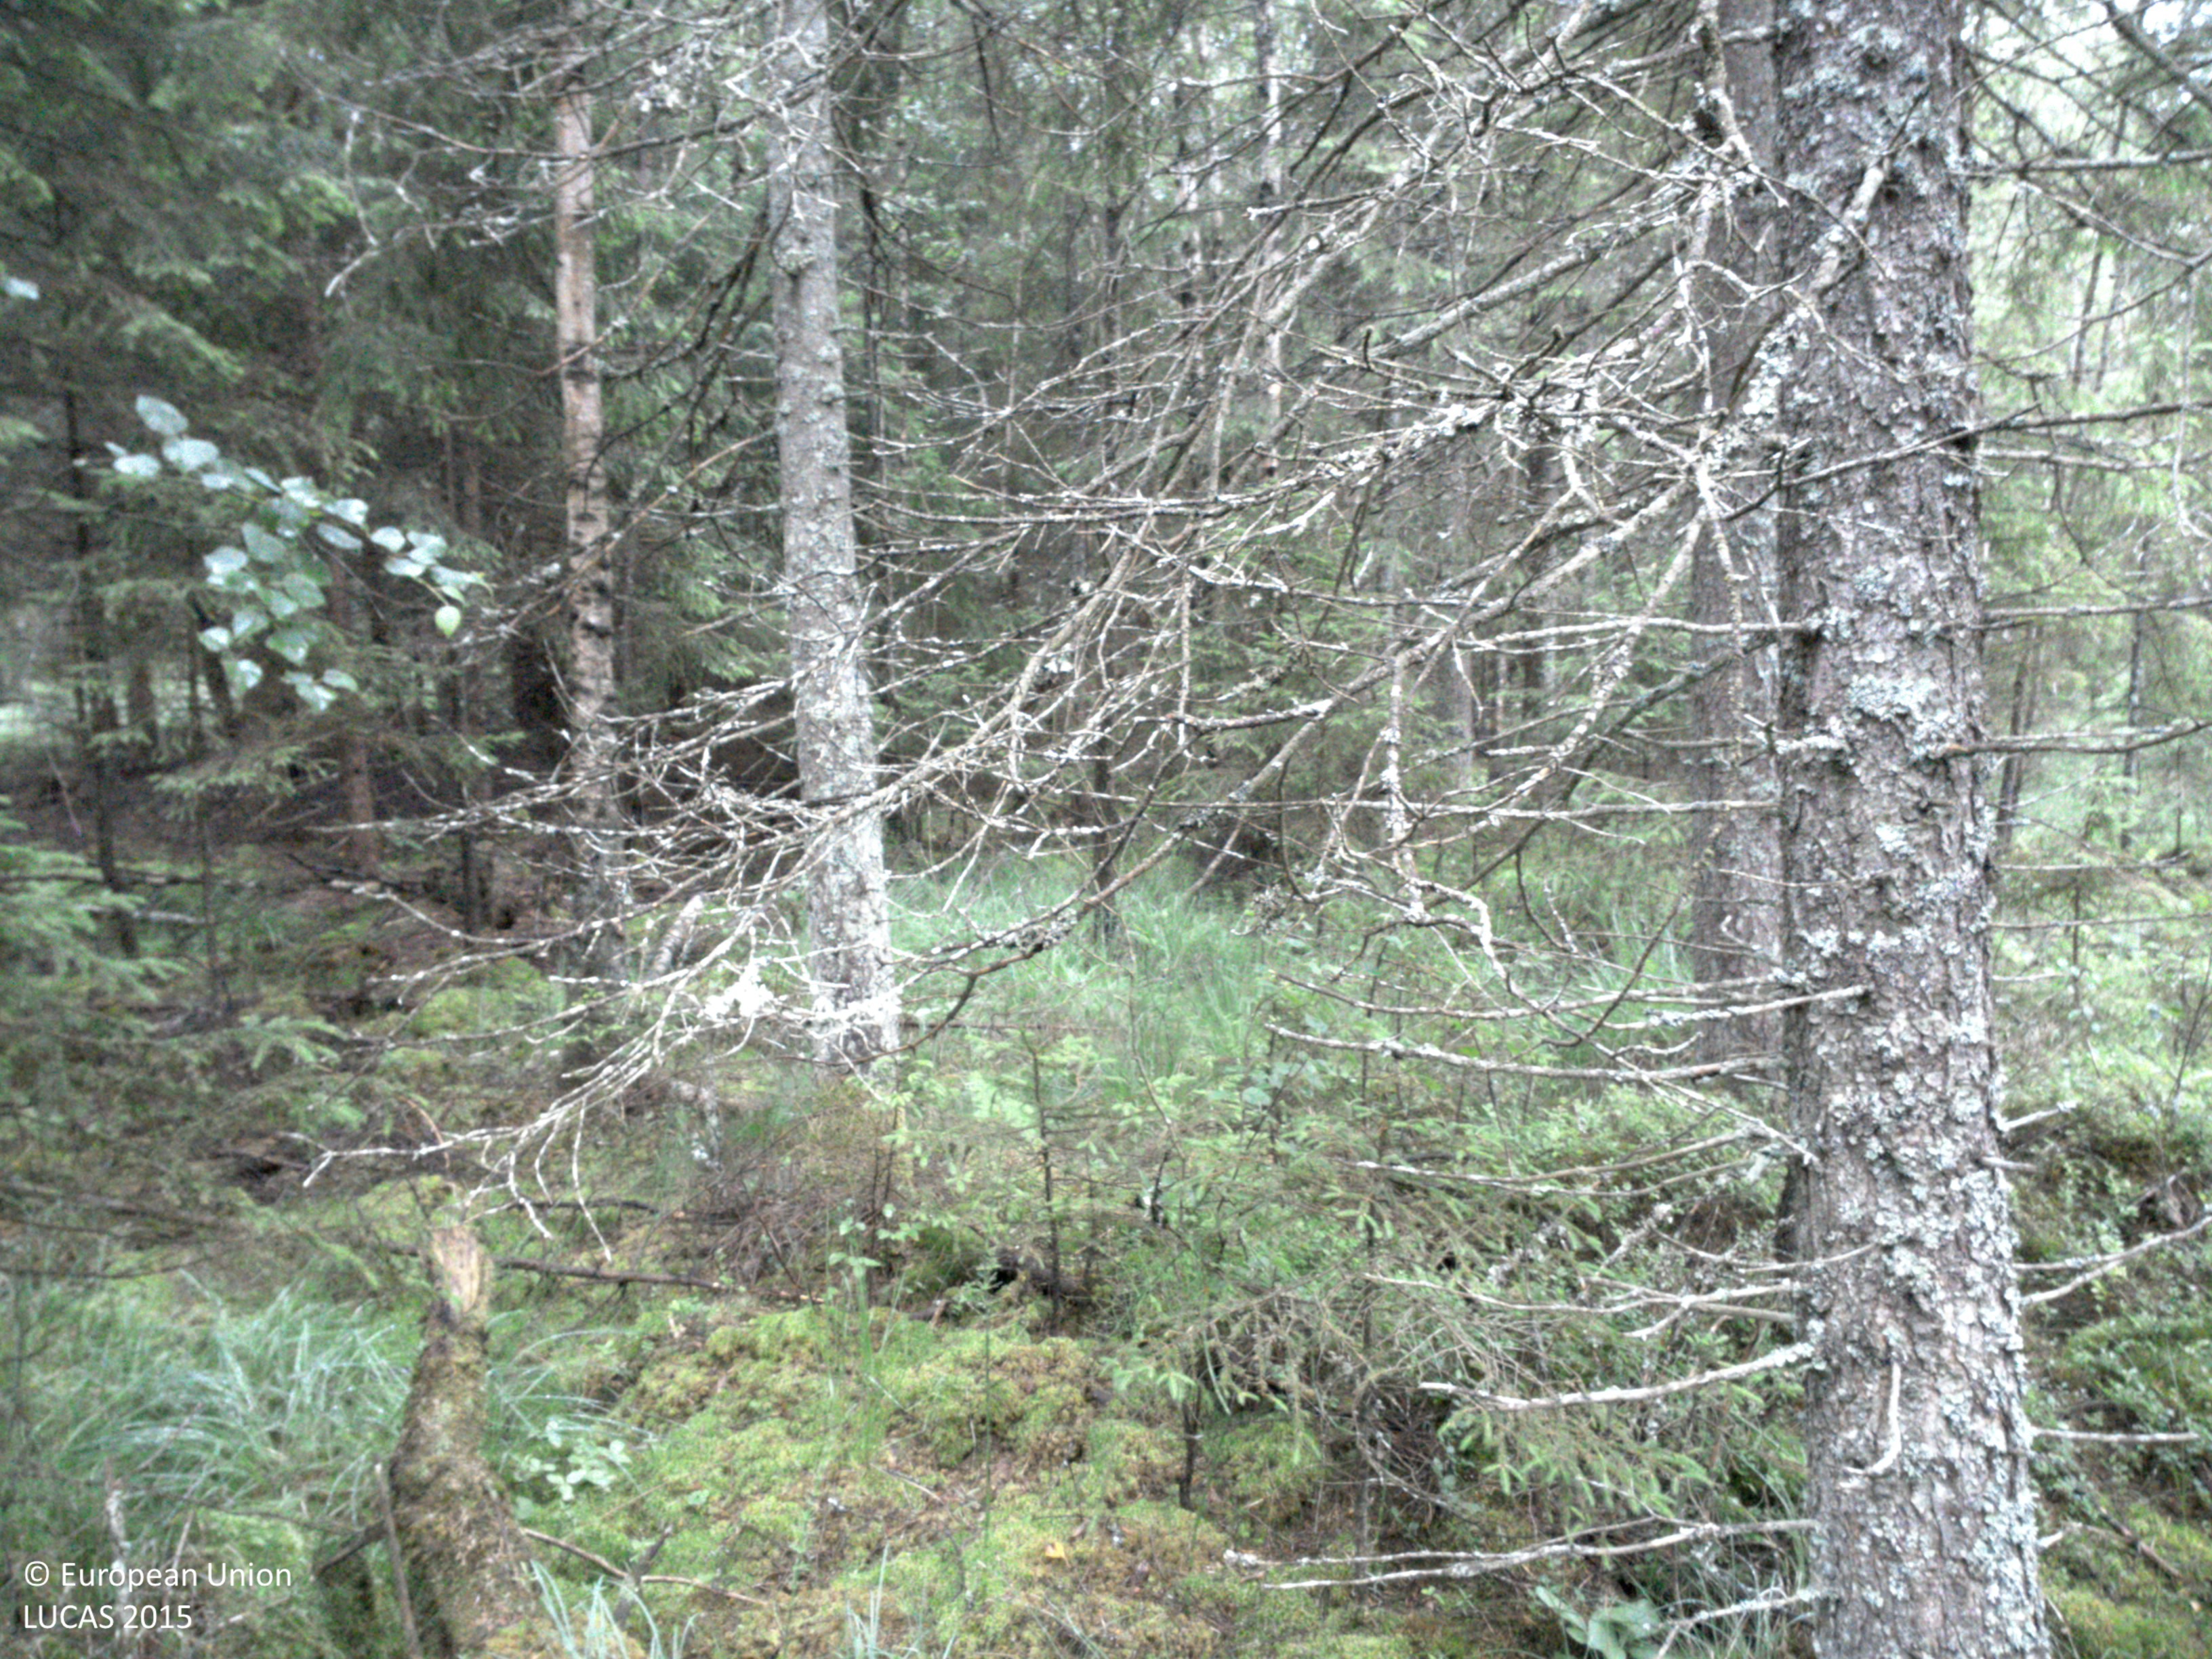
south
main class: Woodland
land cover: Spruce dominated mixed woodland
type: boreal forest
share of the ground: 50 - 75 %
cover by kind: coniferous forest trees 40 %, broadleaved forest trees 20 %, herbaceous plants 20 %, lichens and mosses 20 %
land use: Forestry
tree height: > 5 m
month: July
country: SE
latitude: 58.7092
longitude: 11.9463
